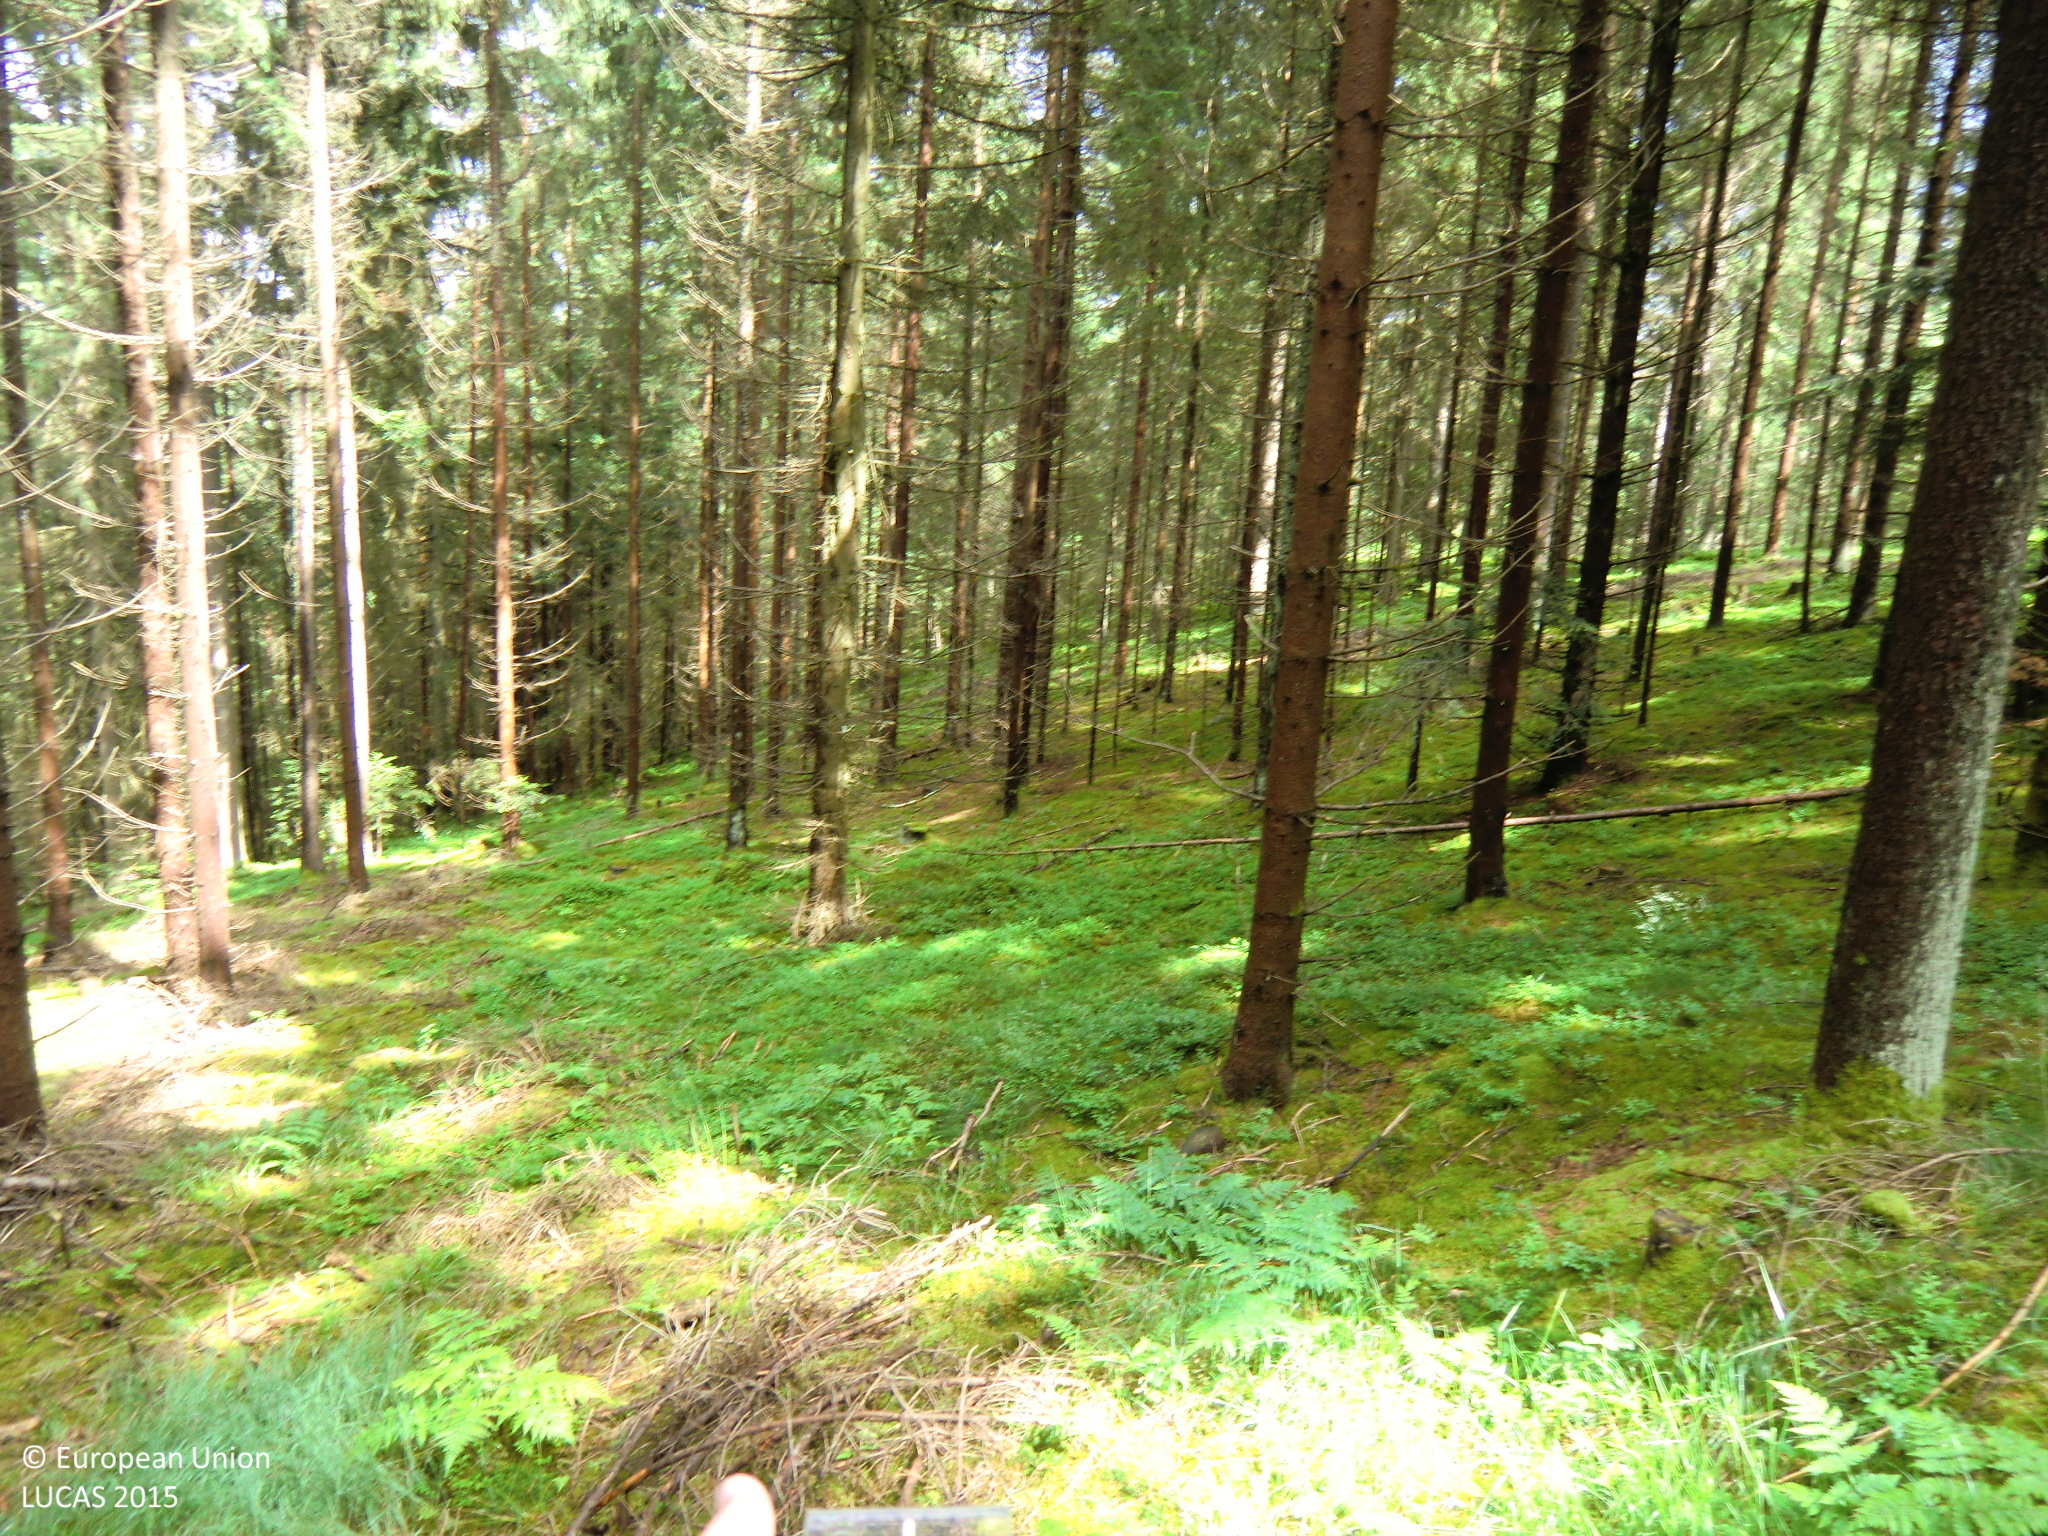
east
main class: Woodland
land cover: Spruce dominated coniferous woodland
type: hemiboreal forest and nemoral coniferous forest and mixed broadleaved-coniferous forest
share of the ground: > 75 %
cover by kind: coniferous forest trees 75 %, lichens and mosses 15 %, herbaceous plants 10 %
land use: Forestry
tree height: > 5 m
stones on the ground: 10 - 25 %
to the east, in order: Spruce dominated coniferous woodland; Tracks; Spruce dominated coniferous woodland; Tracks; Pine dominated mixed woodland; Spruce dominated coniferous woodland; Tracks; Grassland without tree/shrub cover
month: June
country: AT
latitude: 48.4302
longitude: 14.6907
